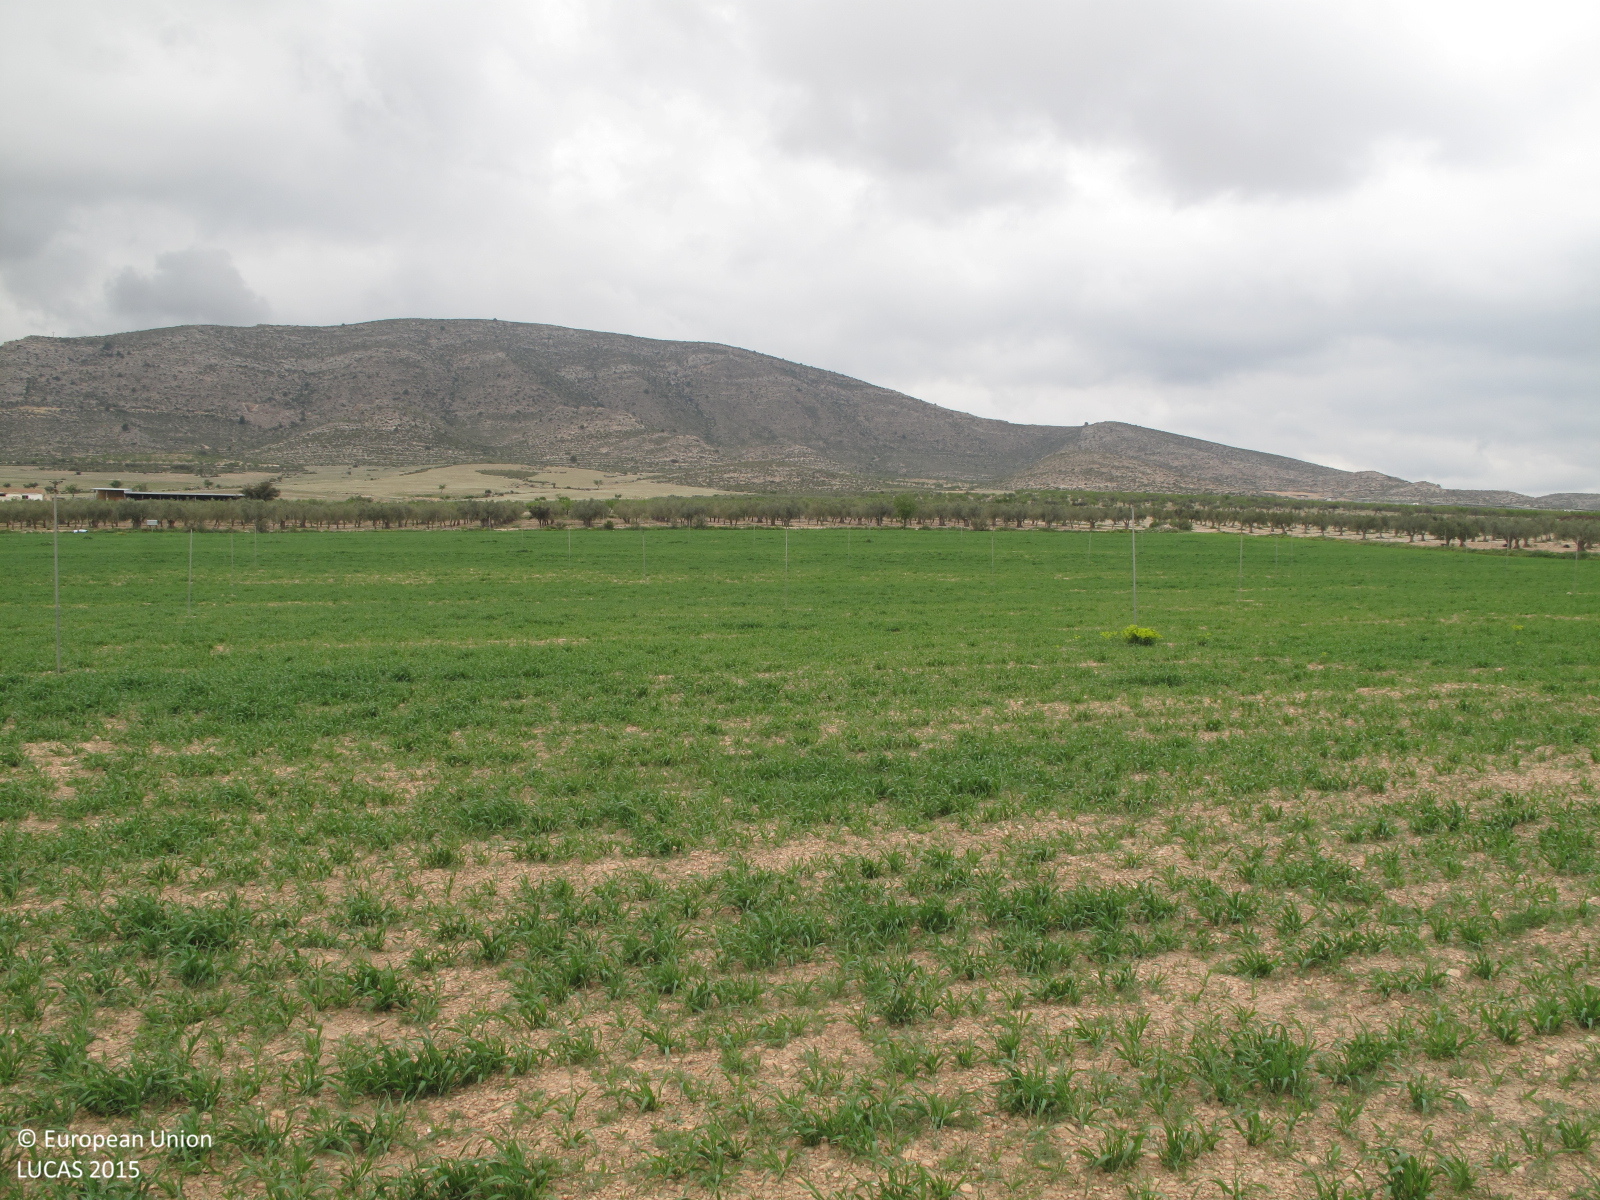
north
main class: Cropland
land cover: Barley
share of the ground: 50 - 75 %
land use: Agriculture (excluding fallow land and kitchen gardens)
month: April
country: ES
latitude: 38.7366
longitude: -0.9785
